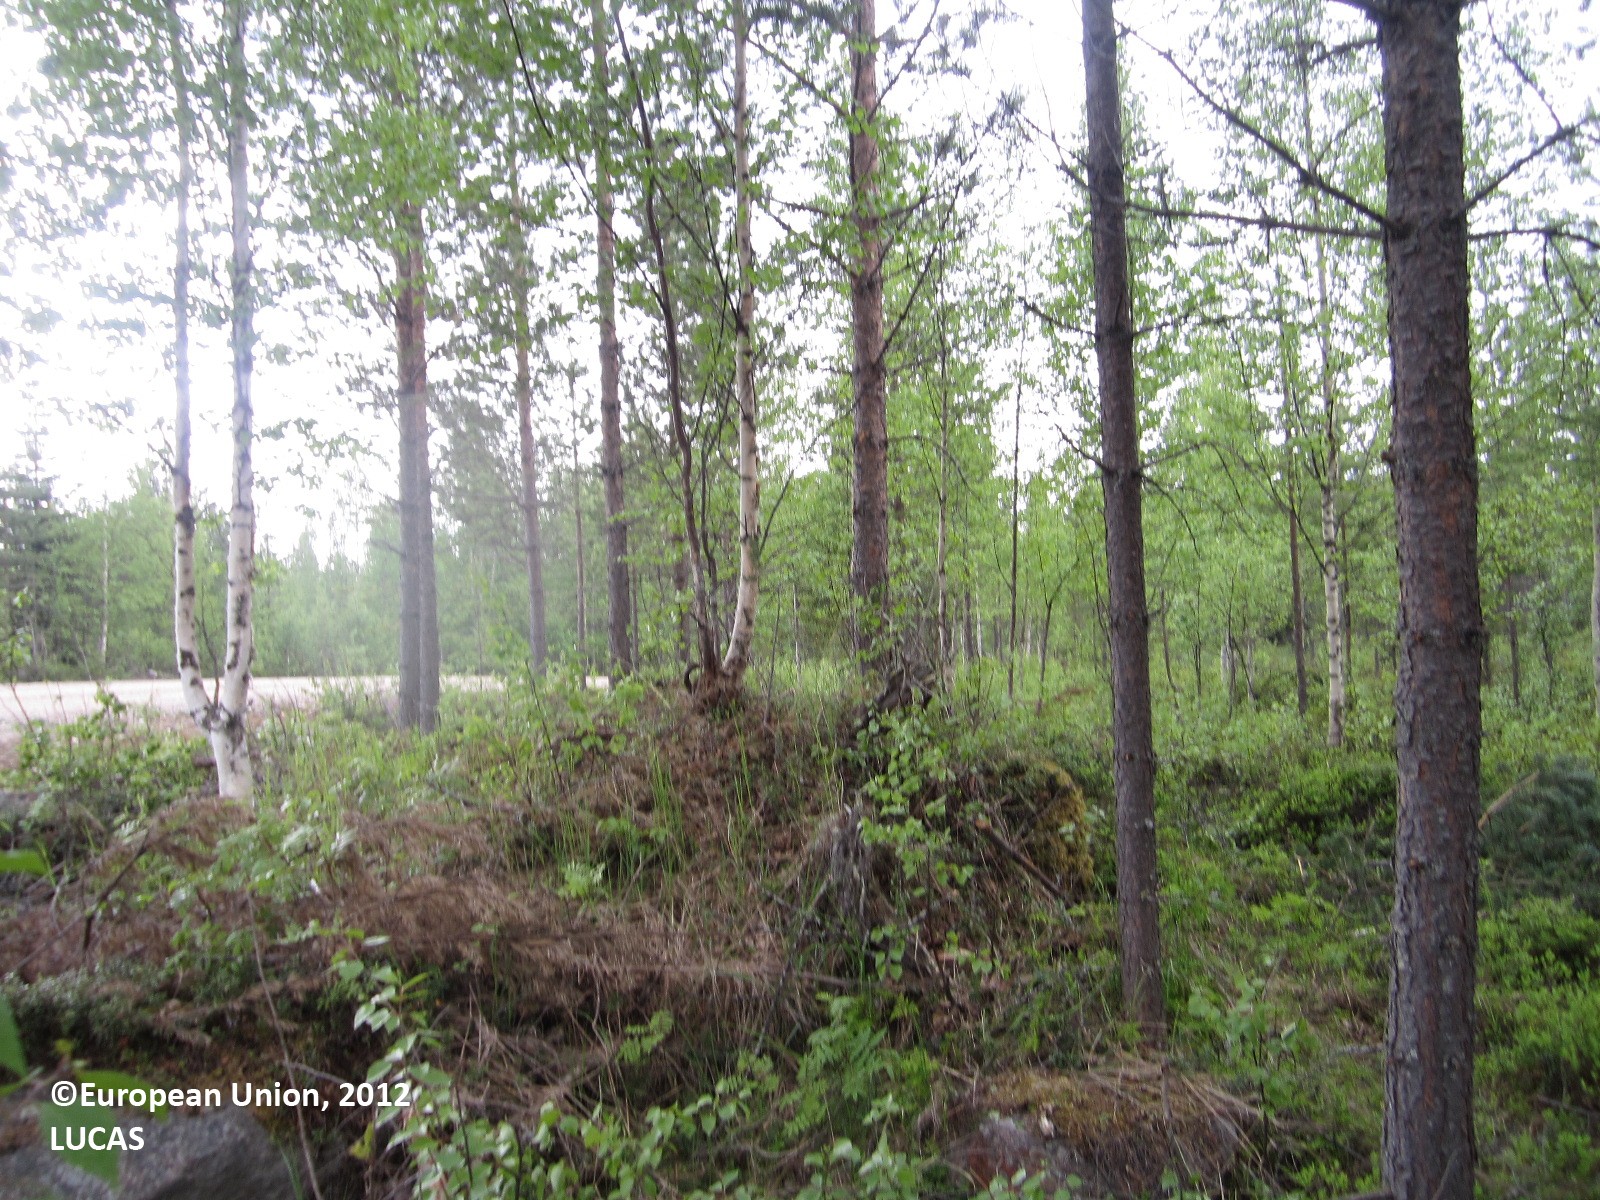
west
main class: Woodland
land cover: Pine dominated mixed woodland
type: boreal forest
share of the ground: > 75 %
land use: Forestry
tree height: > 5 m
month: June
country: FI
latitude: 65.0247
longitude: 29.1912
